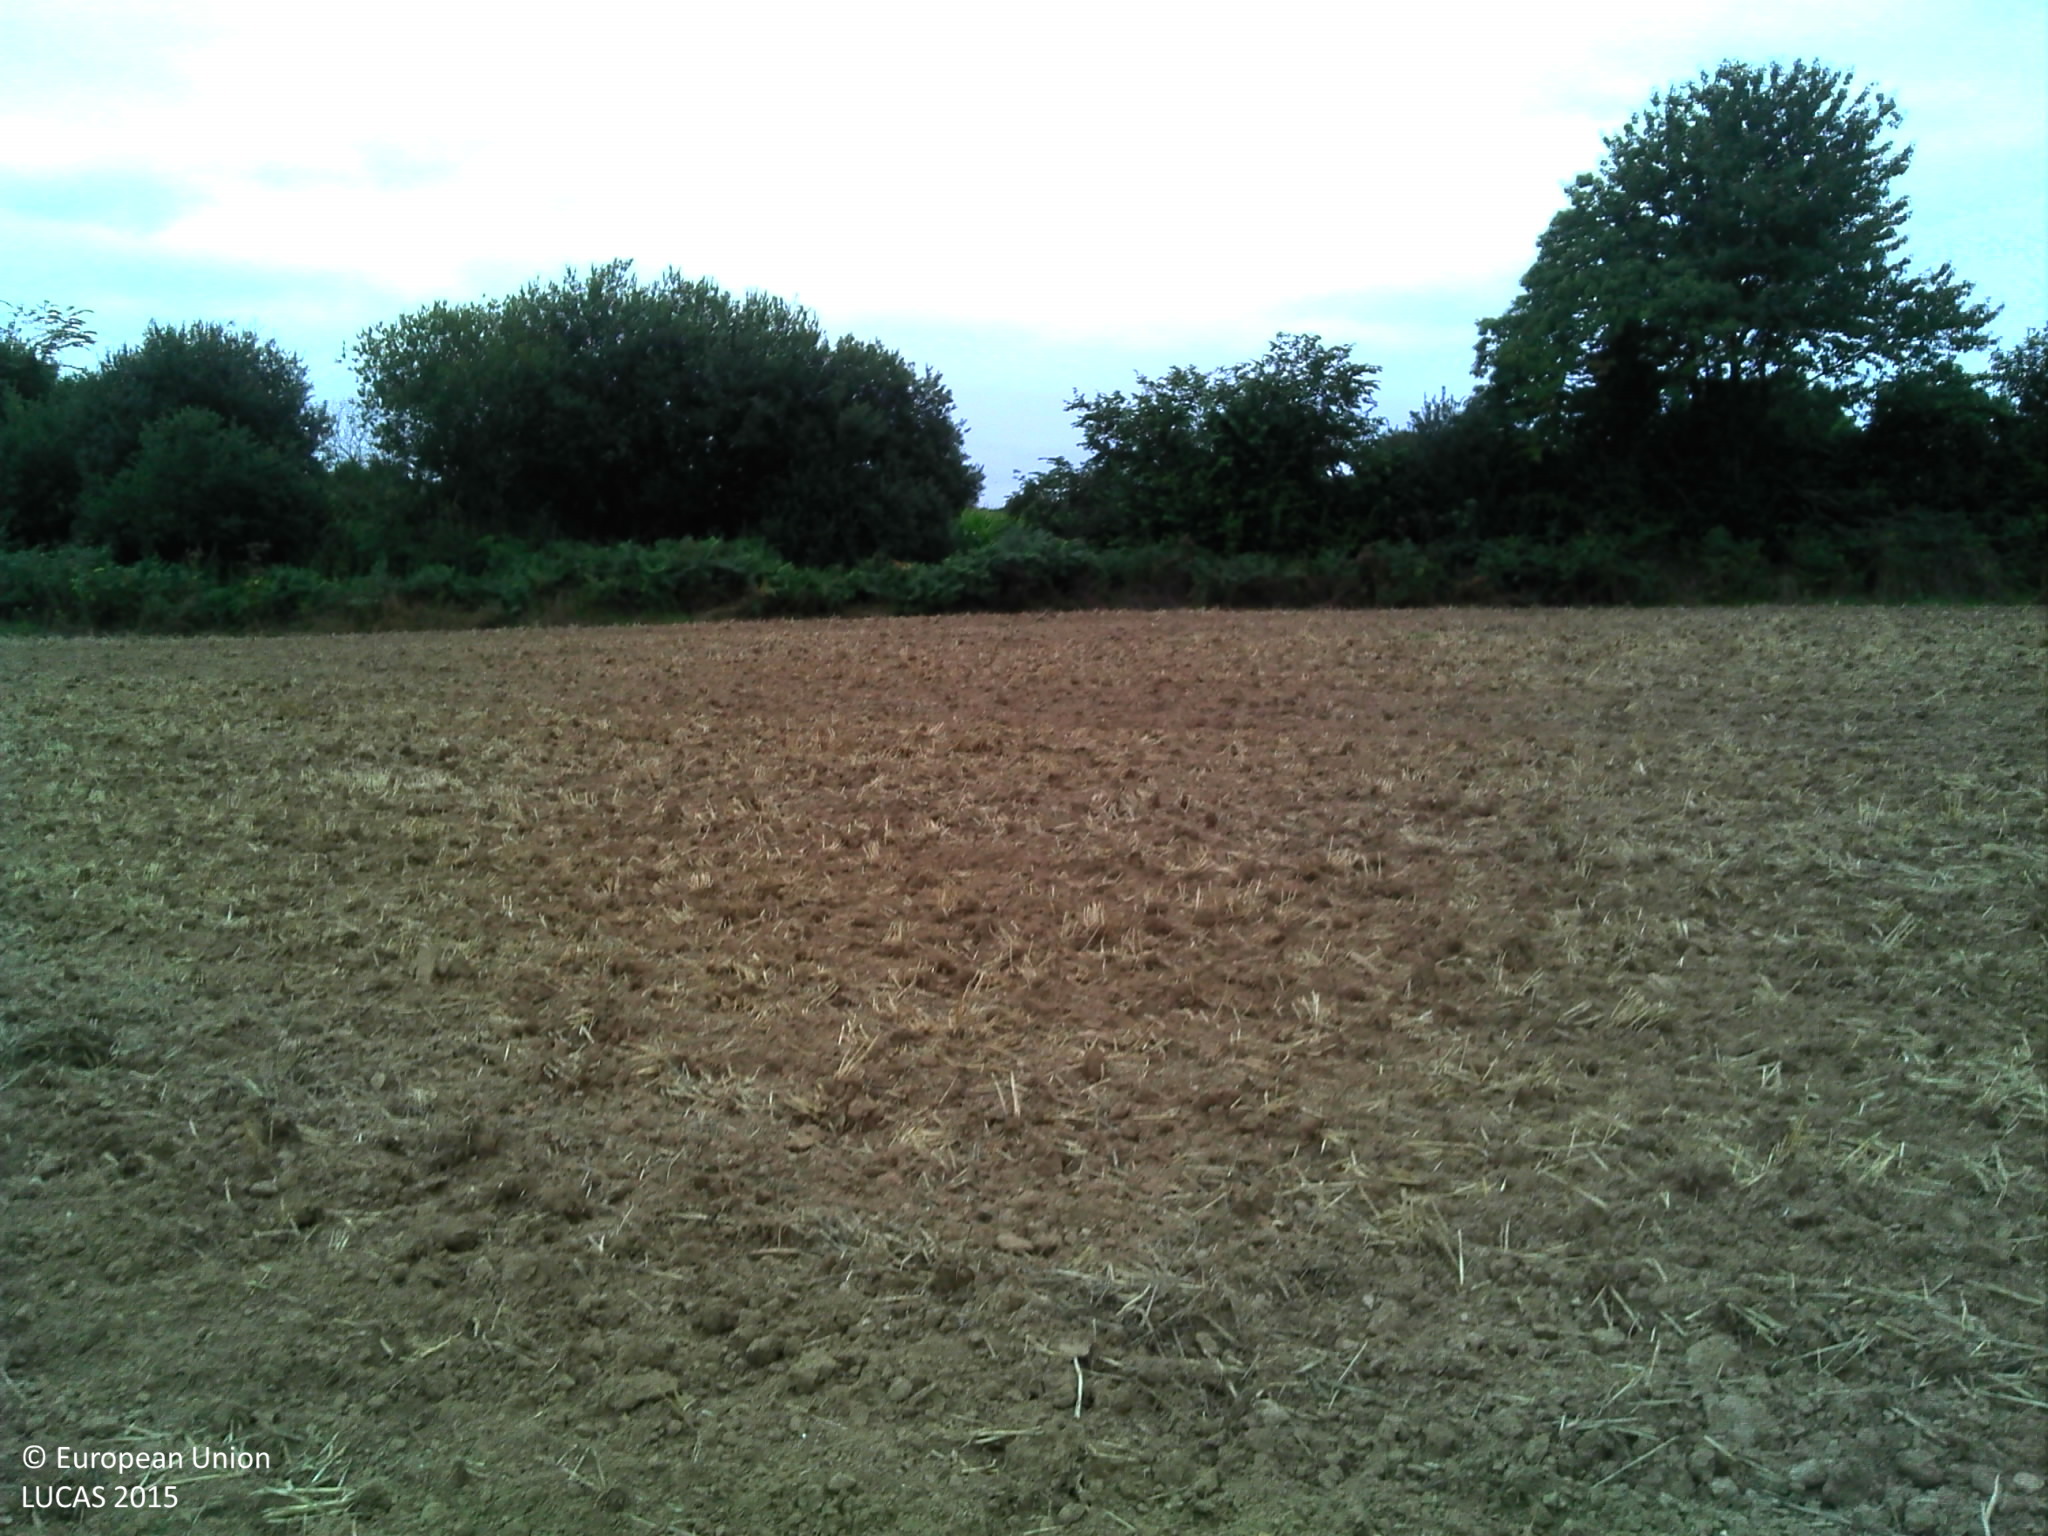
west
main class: Cropland
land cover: Common wheat
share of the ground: > 75 %
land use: Agriculture (excluding fallow land and kitchen gardens)
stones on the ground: < 10 %
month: August
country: FR
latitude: 48.6679
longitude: -3.1771
